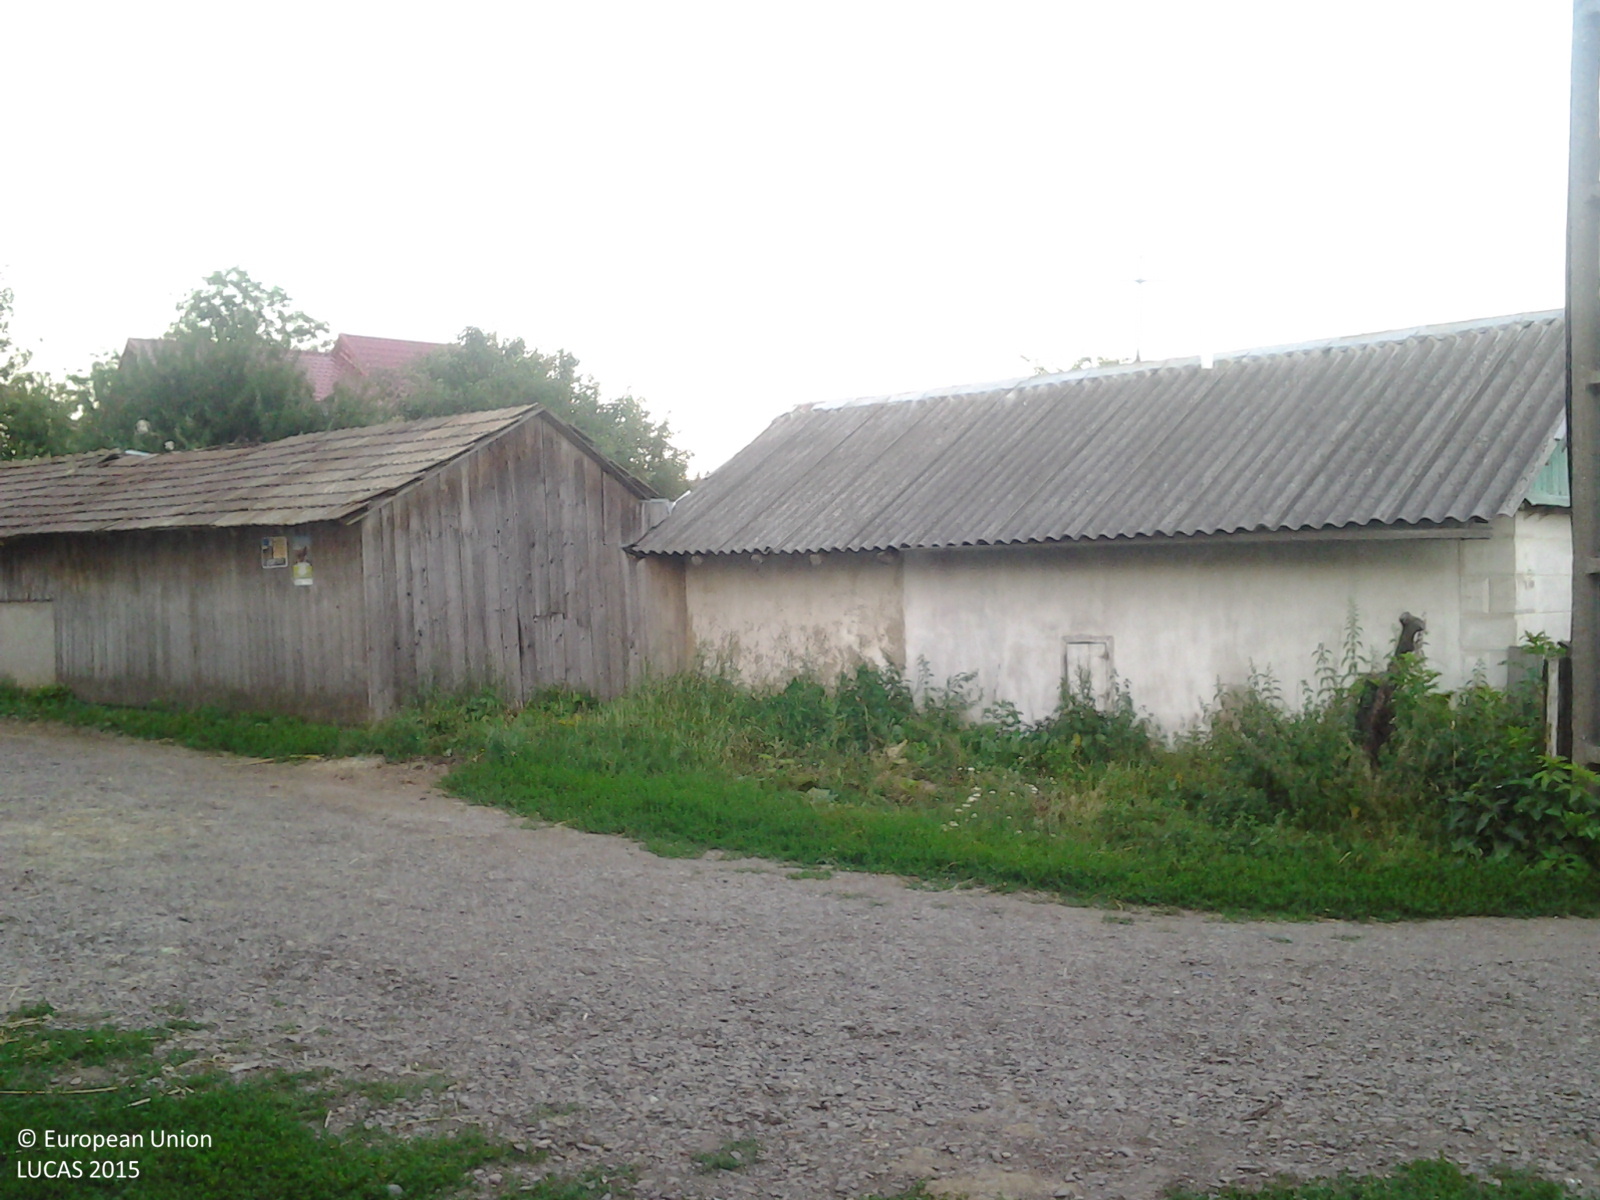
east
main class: Grassland
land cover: Grassland without tree/shrub cover
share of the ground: > 75 %
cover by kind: herbaceous plants 100 %
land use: Agriculture (excluding fallow land and kitchen gardens)
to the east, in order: Grassland without tree/shrub cover; Other fruit trees and berries; Artificial constructions in urban areas; Grassland without tree/shrub cover; Artificial constructions in urban areas; Grassland without tree/shrub cover; Artificial constructions in urban areas; Grassland without tree/shrub cover; Artificial constructions in urban areas
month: June
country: RO
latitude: 47.7430
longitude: 26.4807
